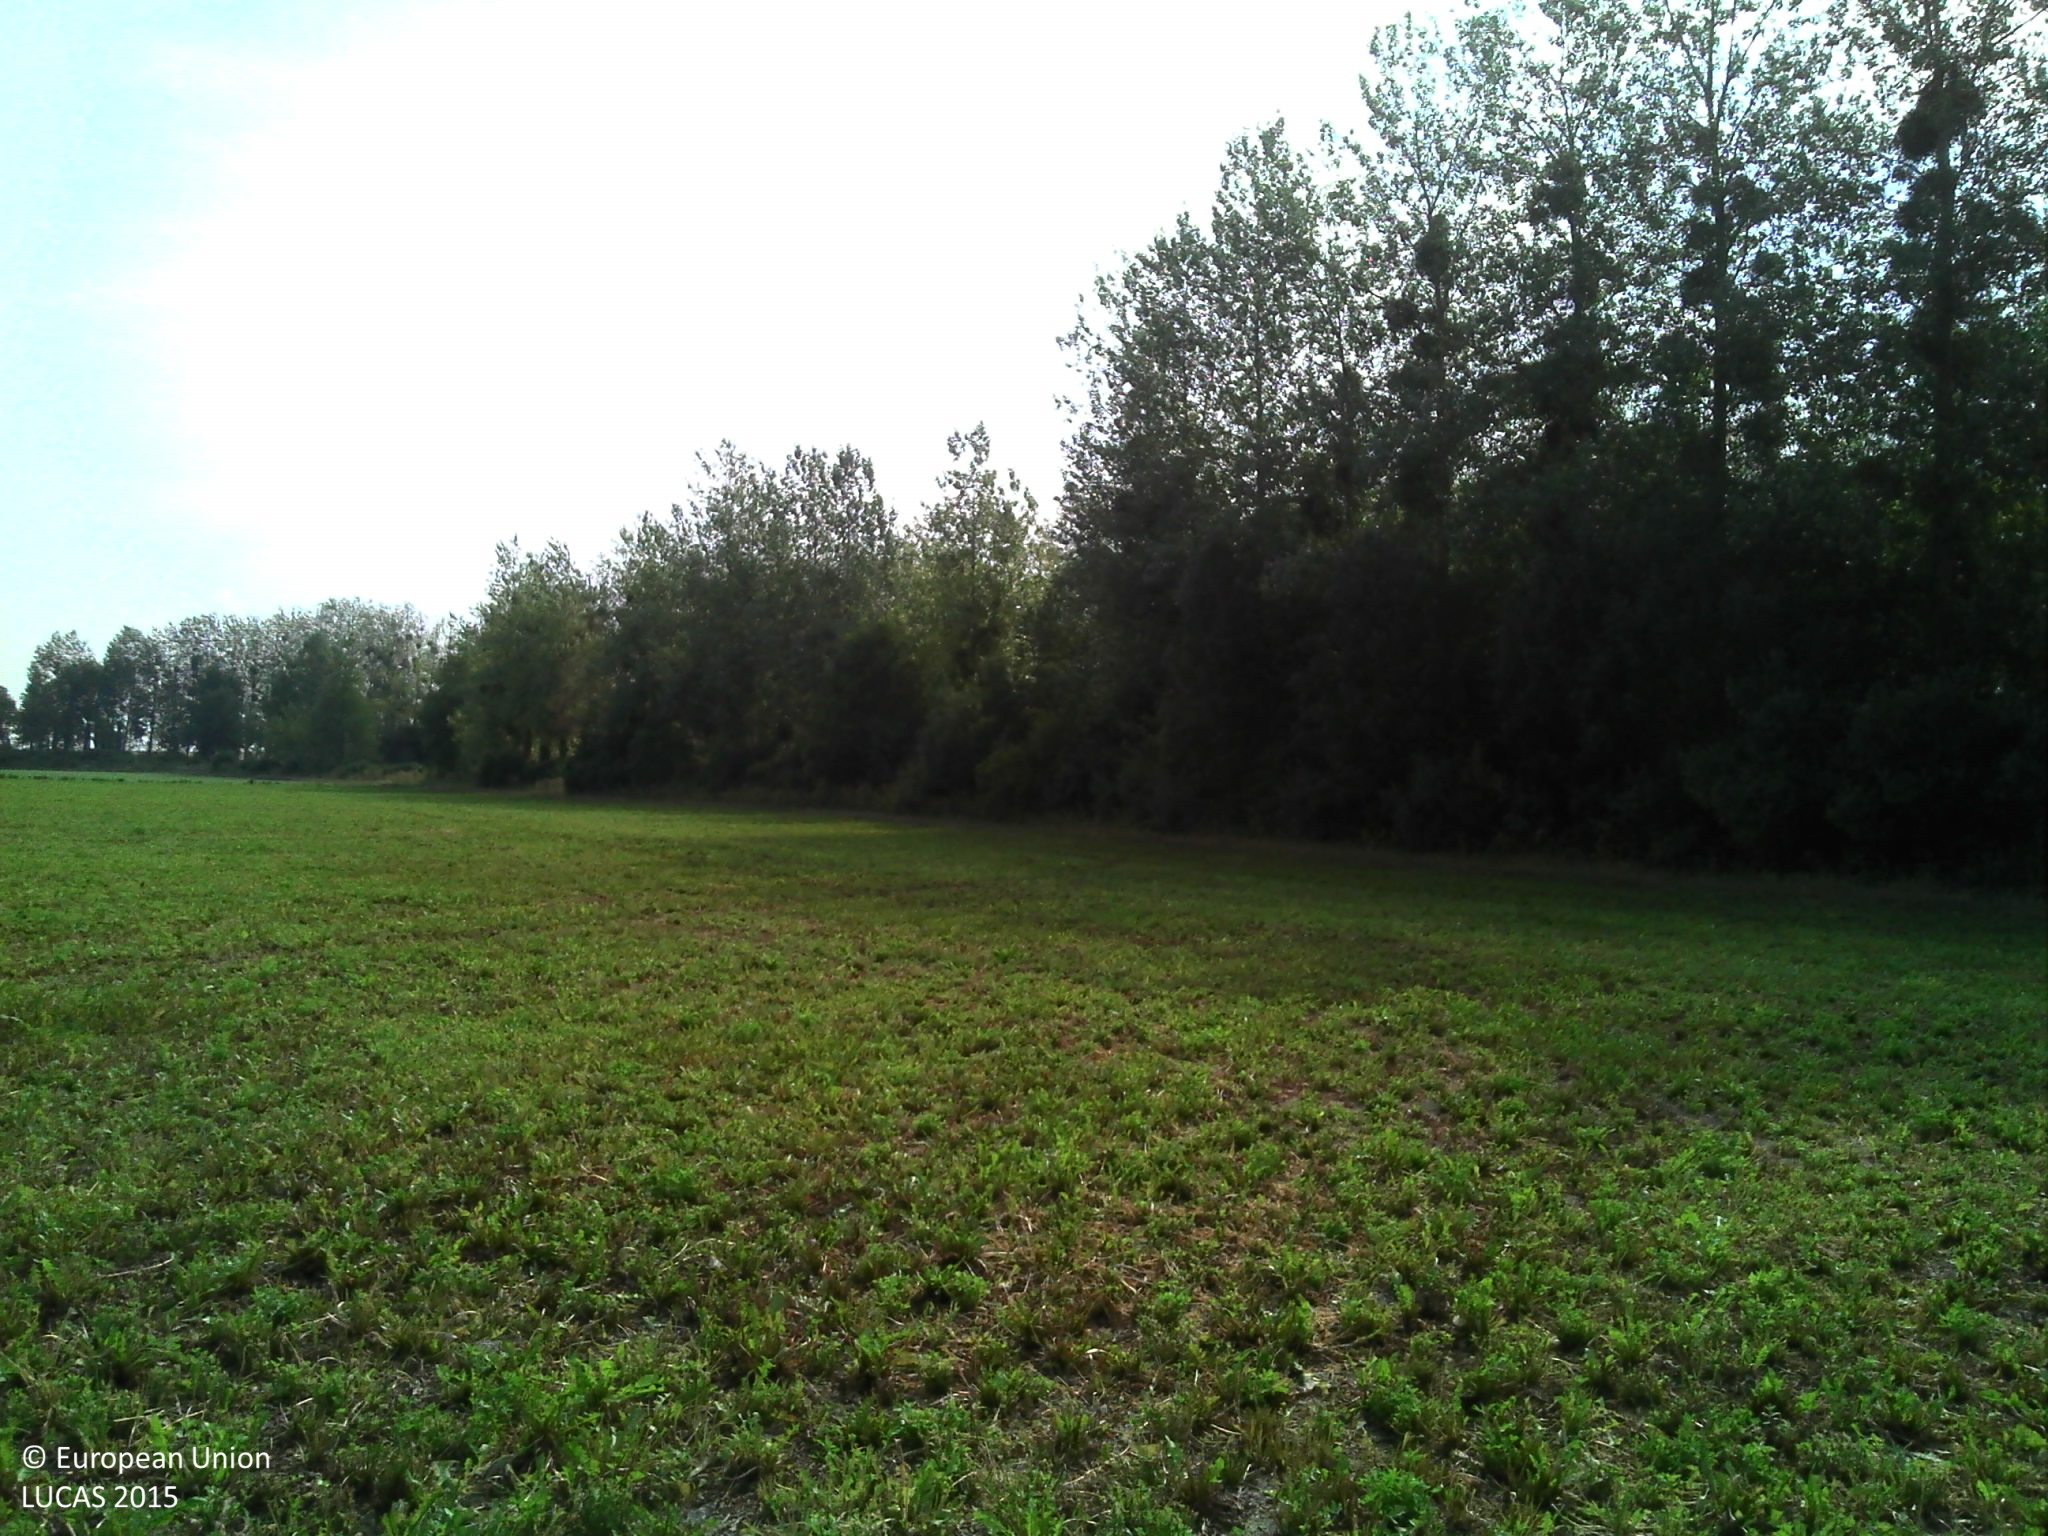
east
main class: Cropland
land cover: Temporary grasslands
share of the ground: > 75 %
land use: Agriculture (excluding fallow land and kitchen gardens)
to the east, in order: Temporary grasslands; Tracks; Grass margins; Broadleaved woodland; Ditches and canals; Rivers and streams; Ditches and canals; Broadleaved woodland; Grass margins; Tracks; Grass margins; Common wheat
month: August
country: FR
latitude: 48.6979
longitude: 3.7856
